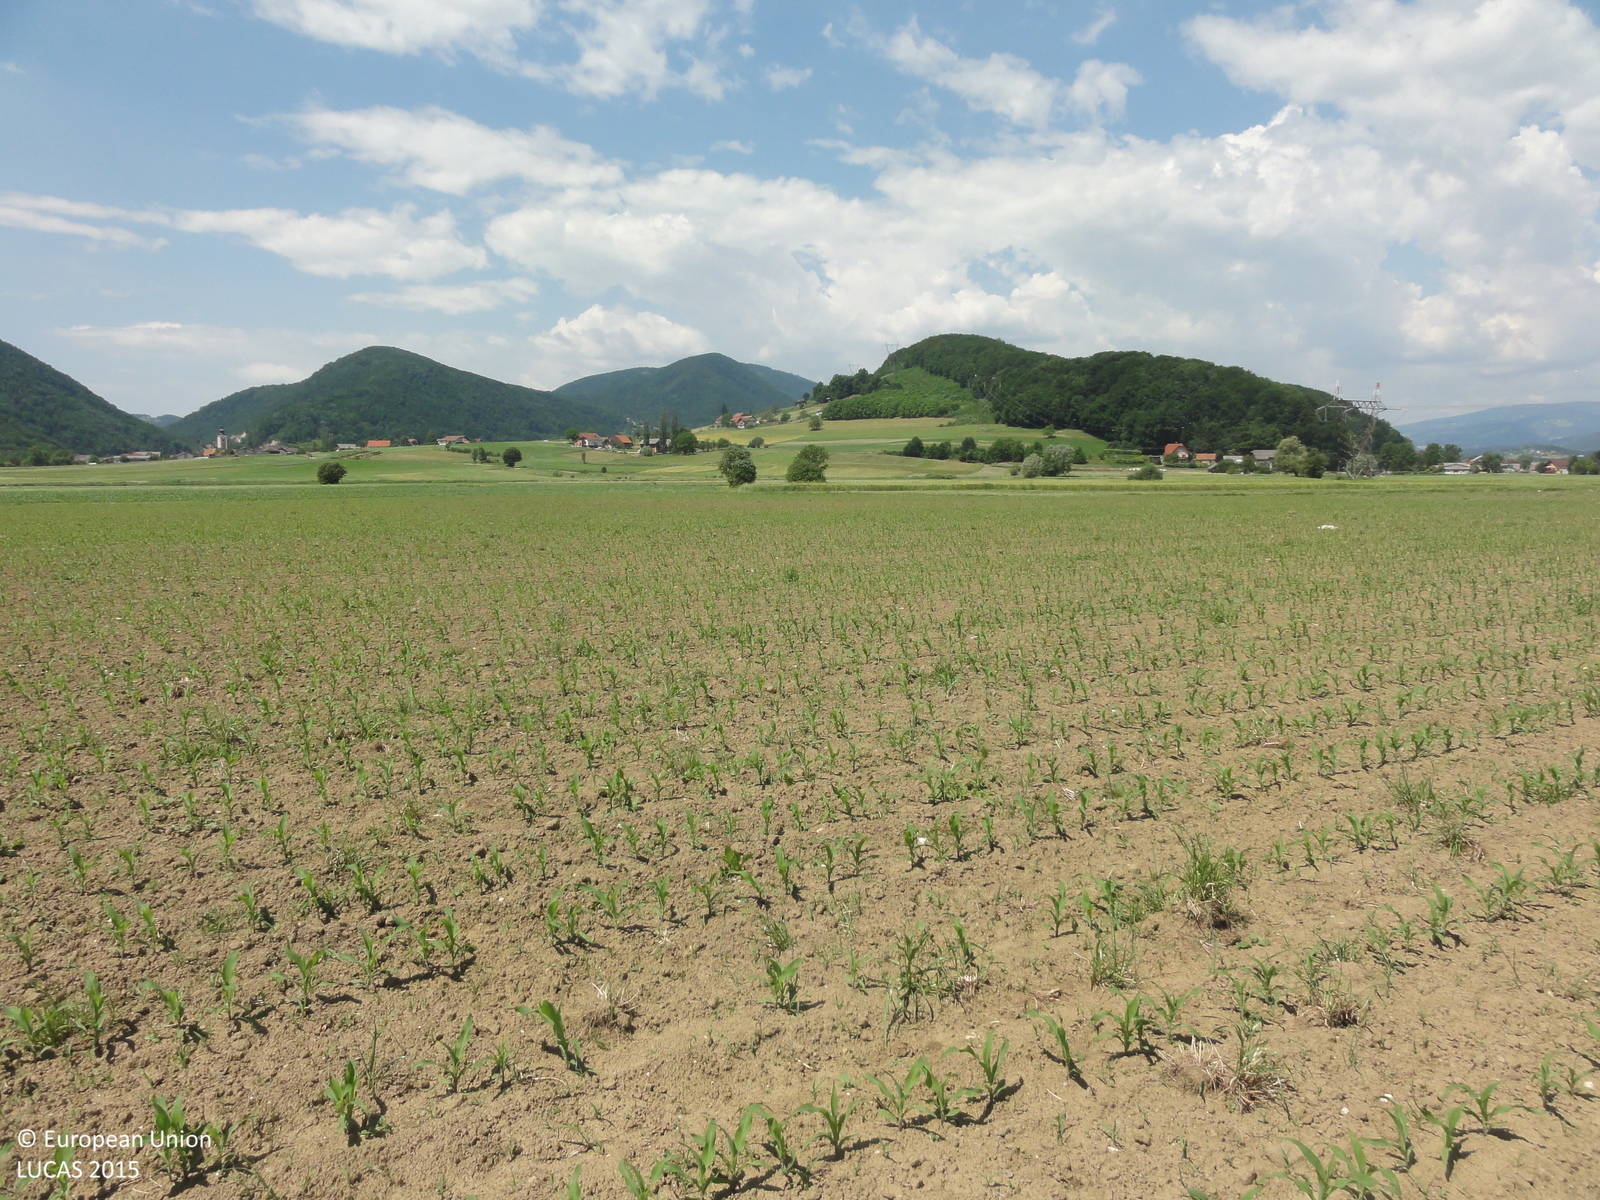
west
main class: Cropland
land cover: Maize
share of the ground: 10 - 25 %
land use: Agriculture (excluding fallow land and kitchen gardens)
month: June
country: SI
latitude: 46.3184
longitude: 15.4918
